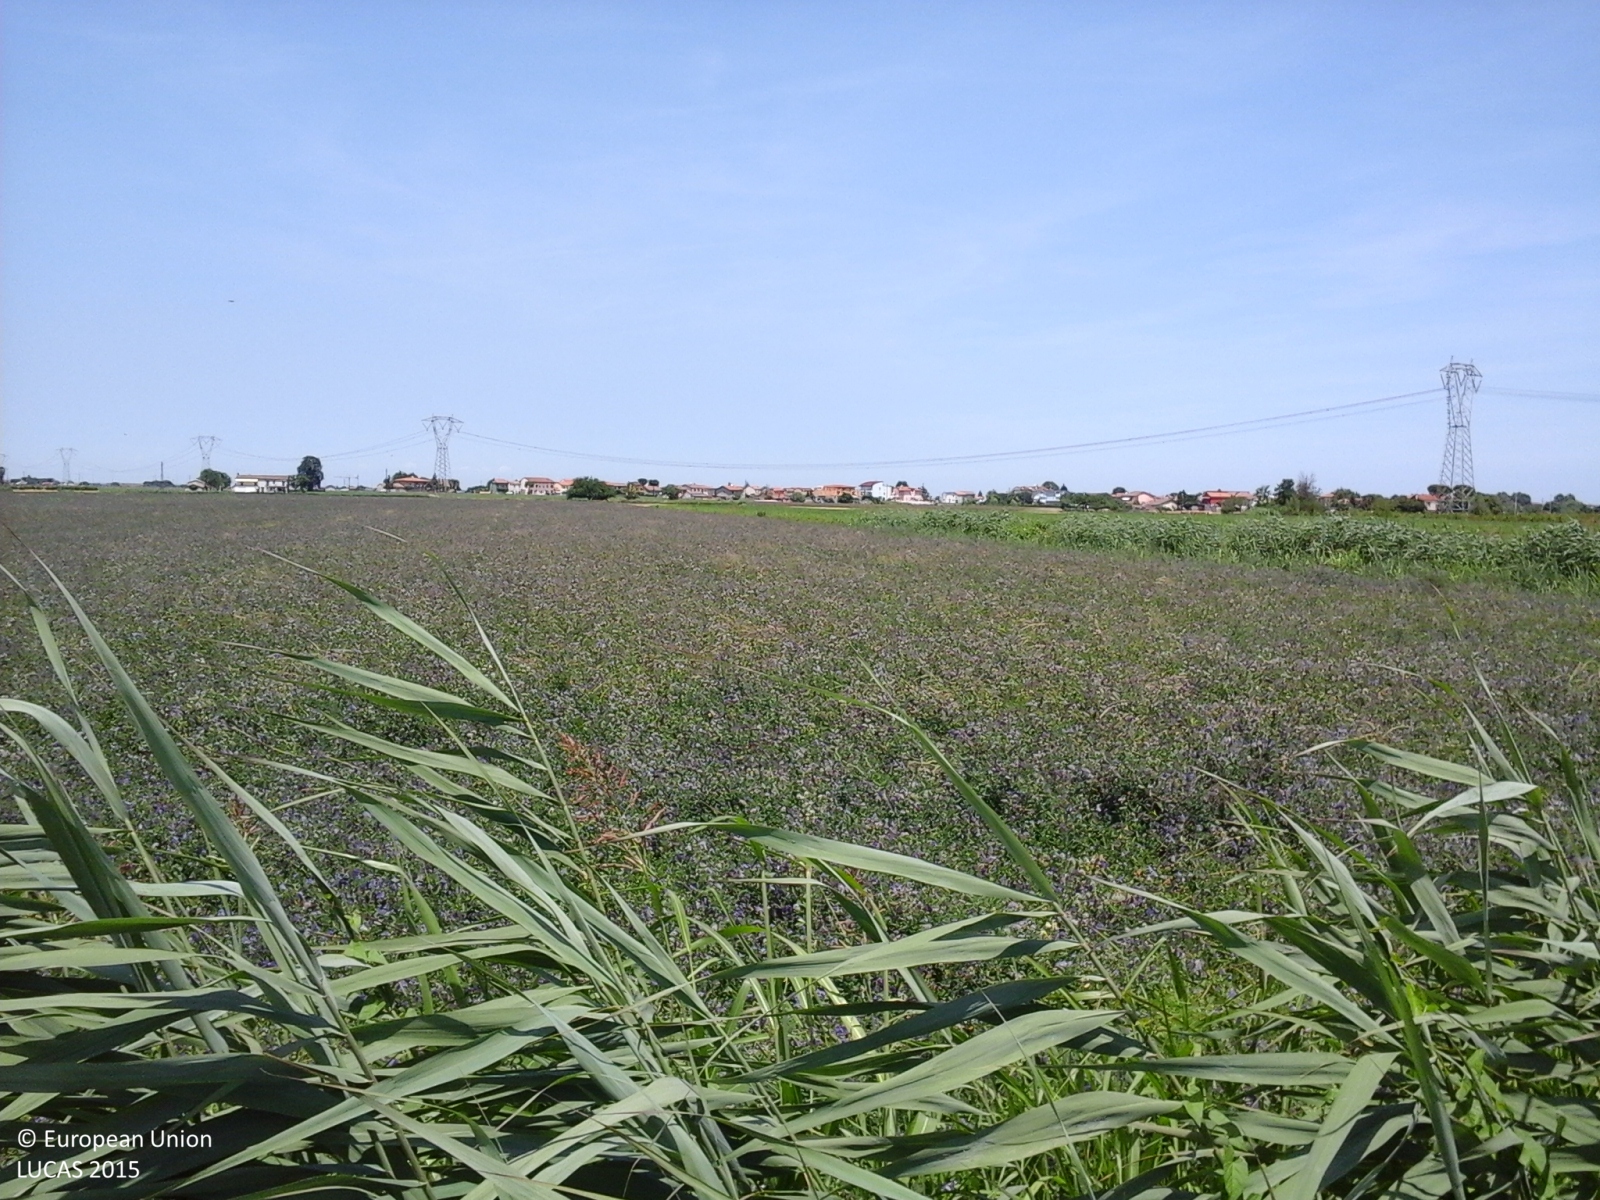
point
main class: Cropland
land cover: Lucerne
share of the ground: > 75 %
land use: Agriculture (excluding fallow land and kitchen gardens)
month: June
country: IT
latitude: 44.1614
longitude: 12.3581
